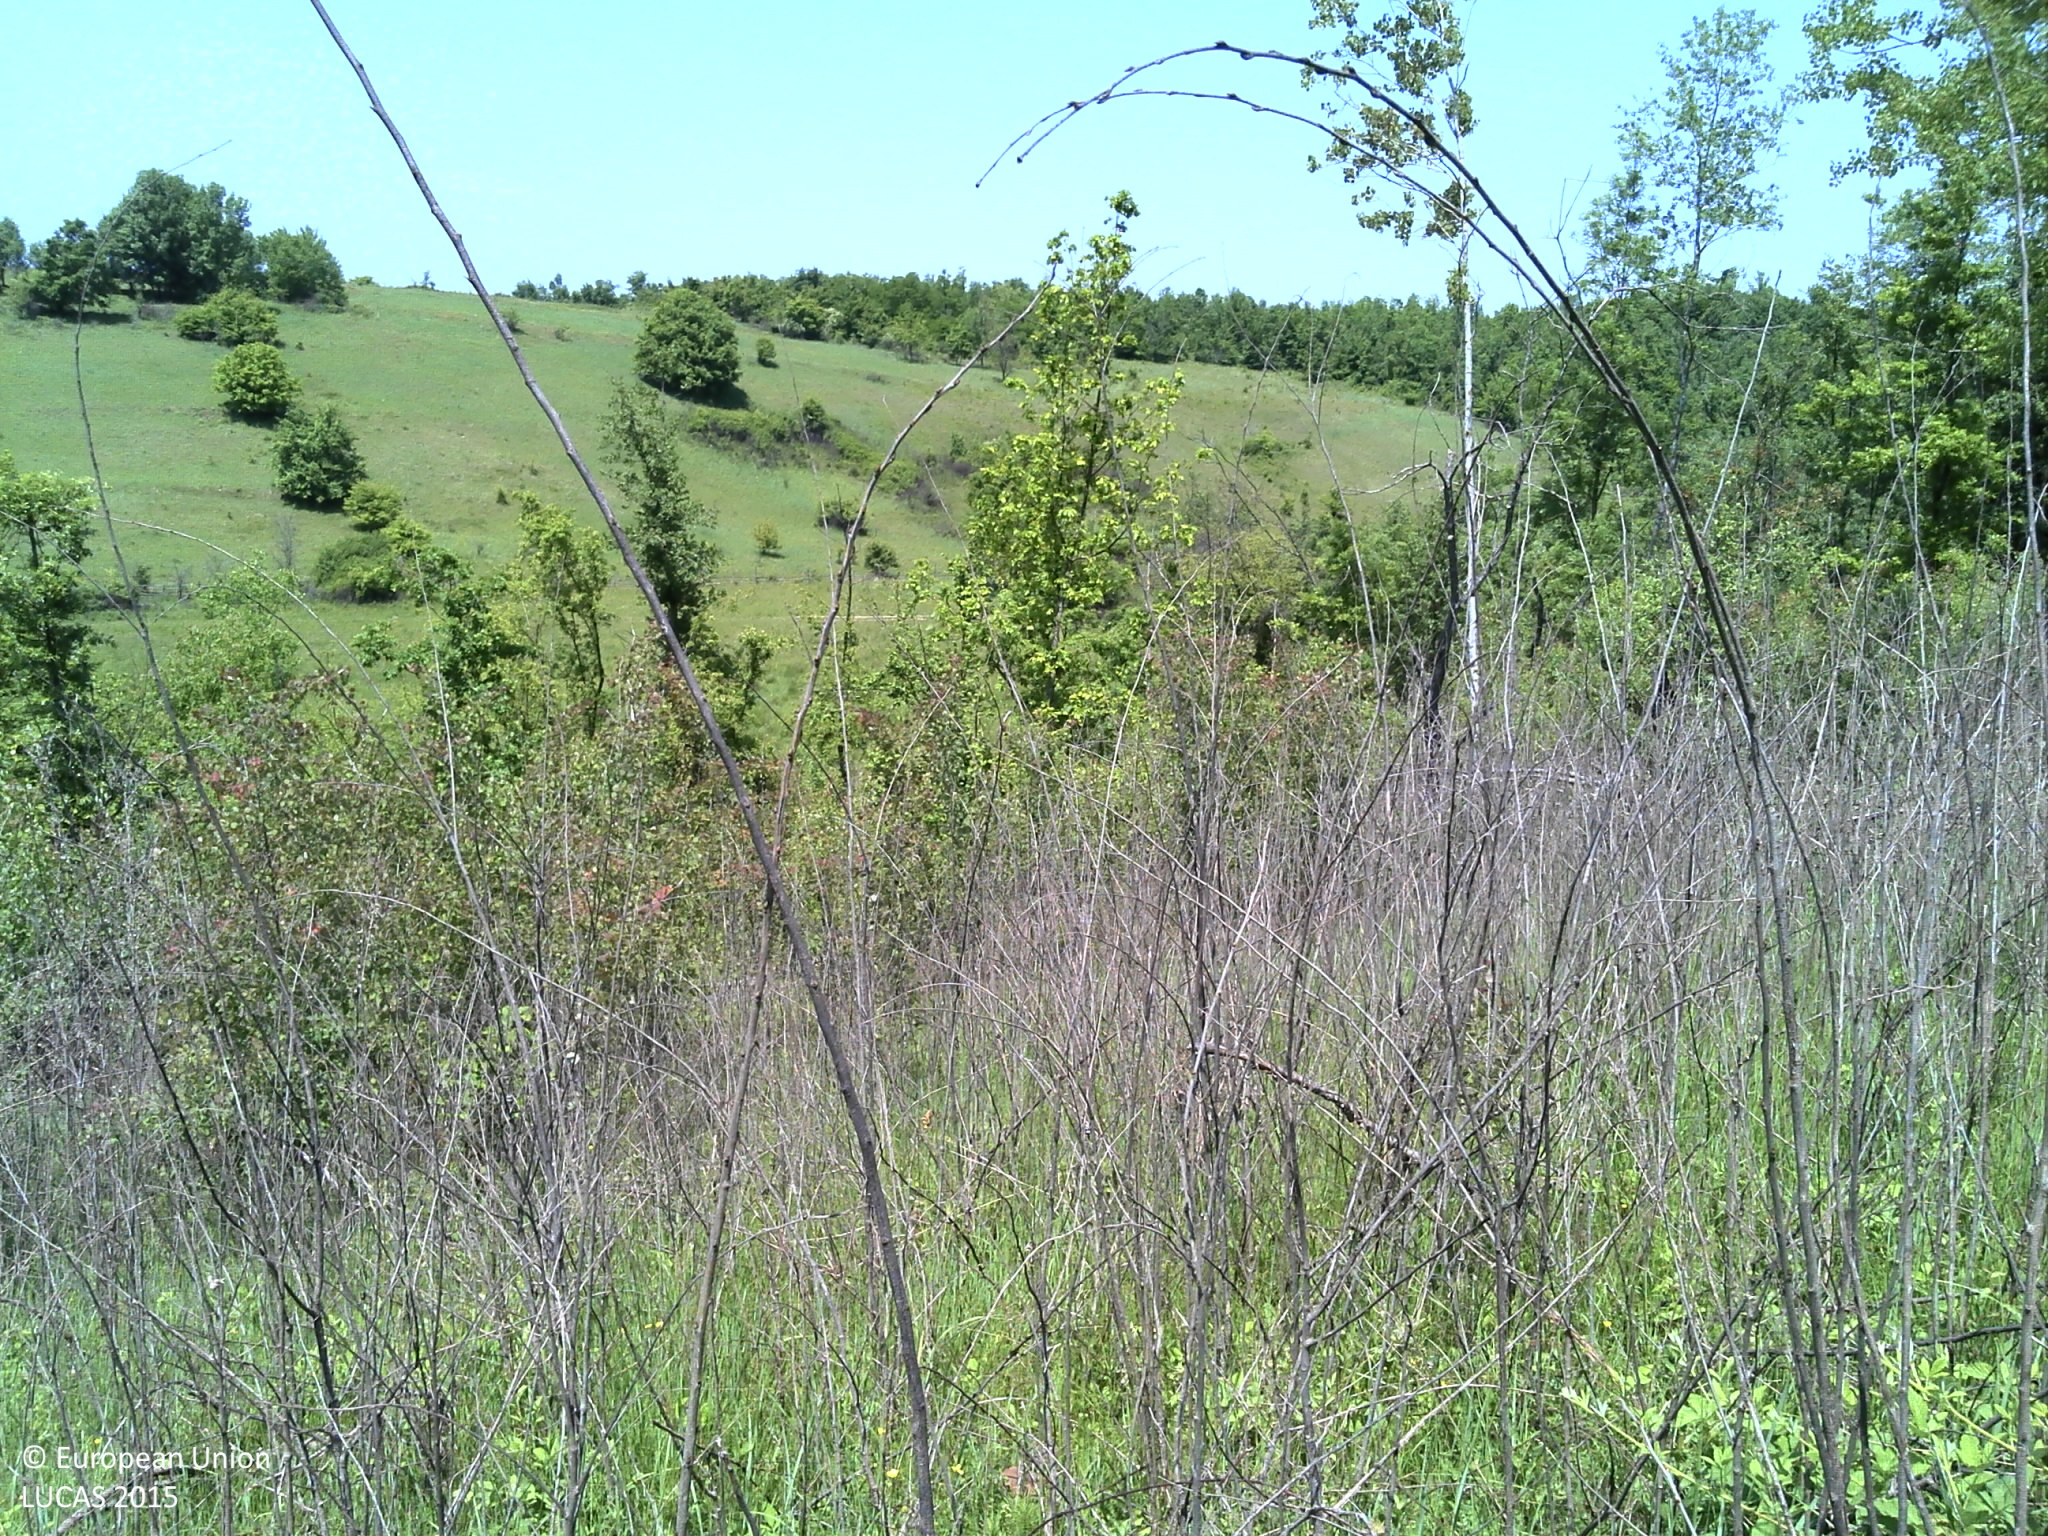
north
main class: Grassland
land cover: Spontaneously vegetated surfaces
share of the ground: > 75 %
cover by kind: herbaceous plants 95 %, shrubs 5 %
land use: Semi-natural and natural areas not in use
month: May
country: HR
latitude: 45.3909
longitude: 18.1147
